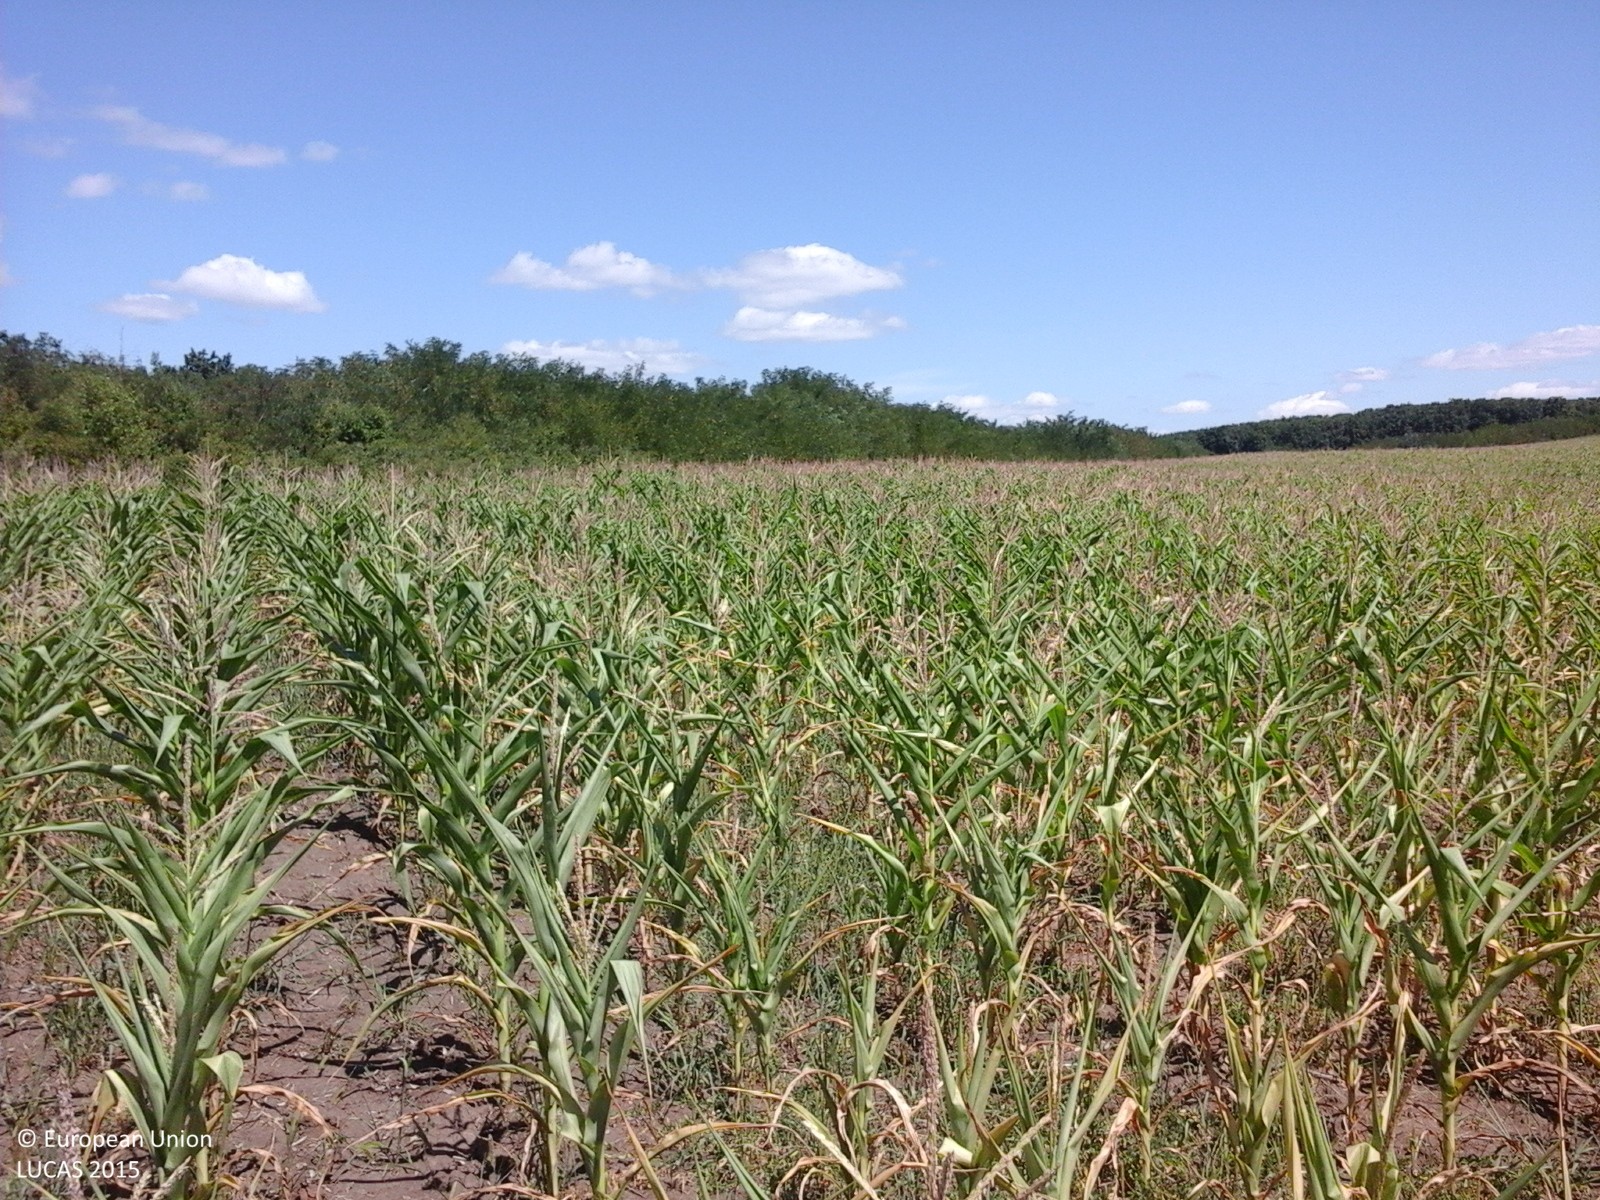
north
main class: Cropland
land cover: Maize
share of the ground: > 75 %
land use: Agriculture (excluding fallow land and kitchen gardens)
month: July
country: RO
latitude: 45.9433
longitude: 27.7204
